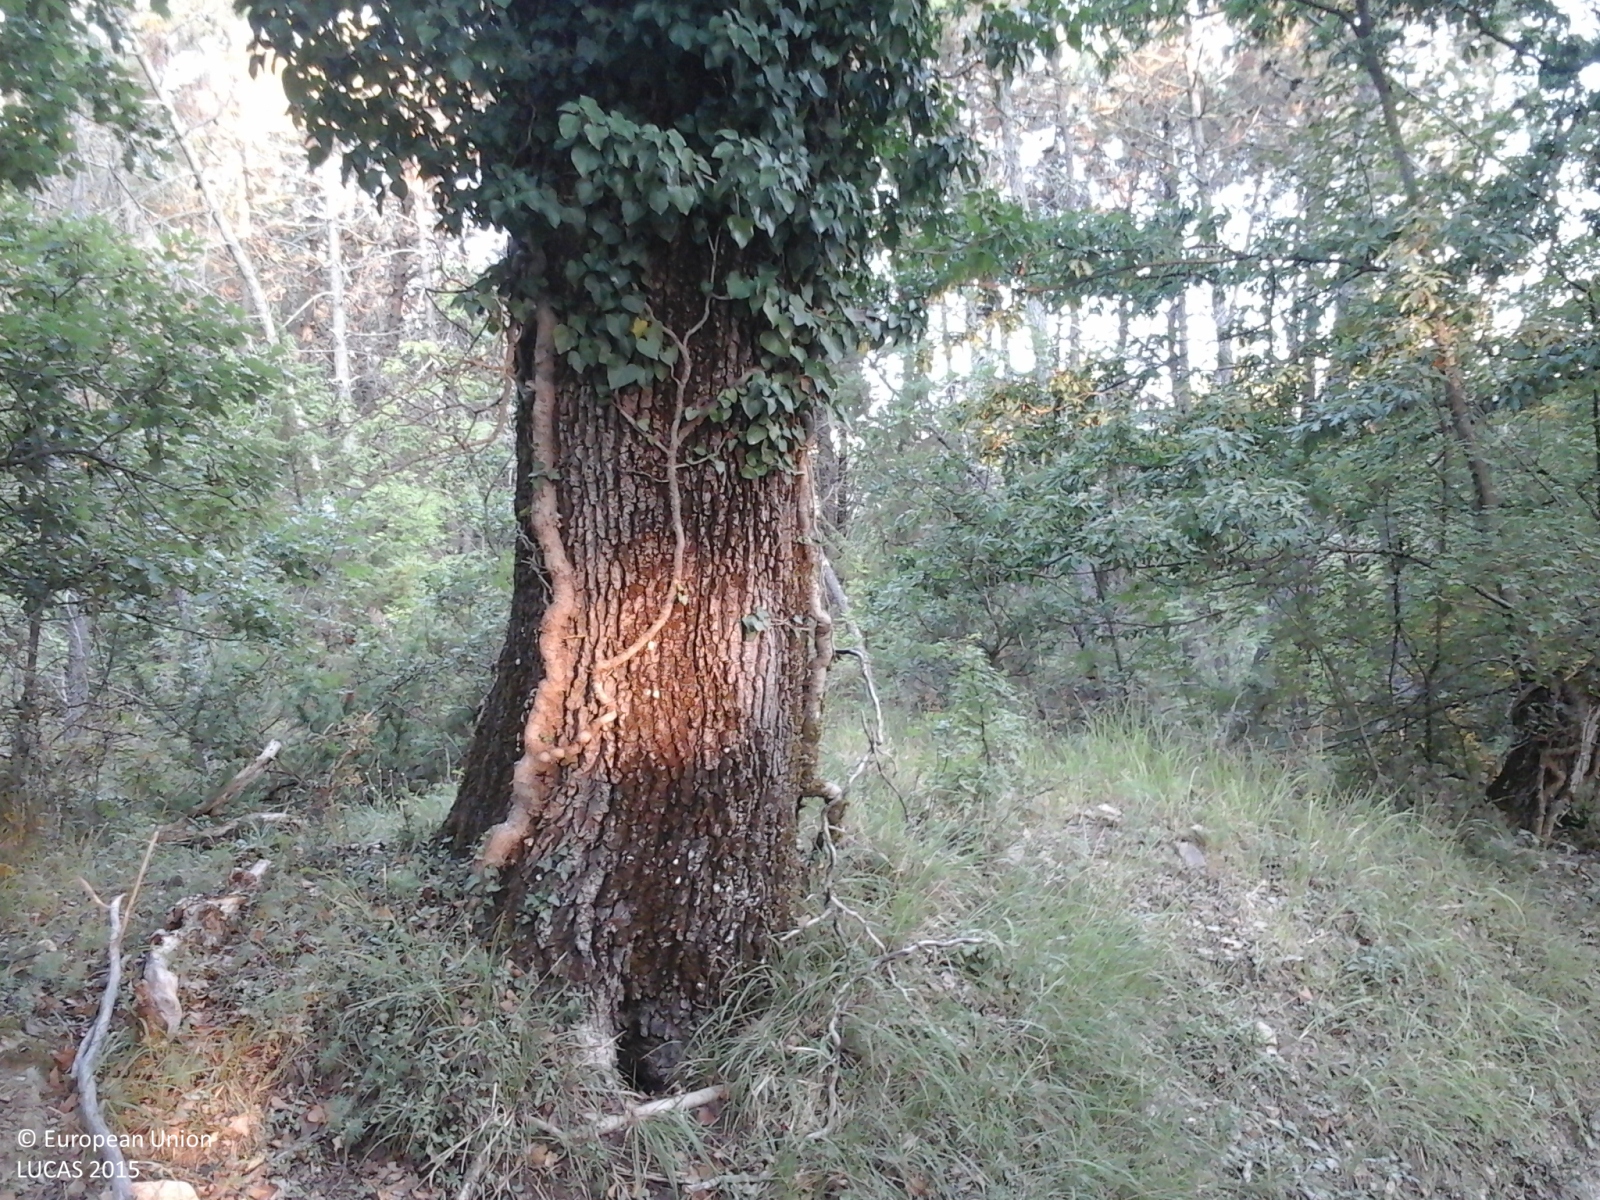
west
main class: Woodland
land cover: Broadleaved woodland
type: thermophilous deciduous forest
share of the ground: > 75 %
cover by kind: broadleaved forest trees 100 %
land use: Forestry
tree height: > 5 m
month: July
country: IT
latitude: 43.2618
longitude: 11.1177
